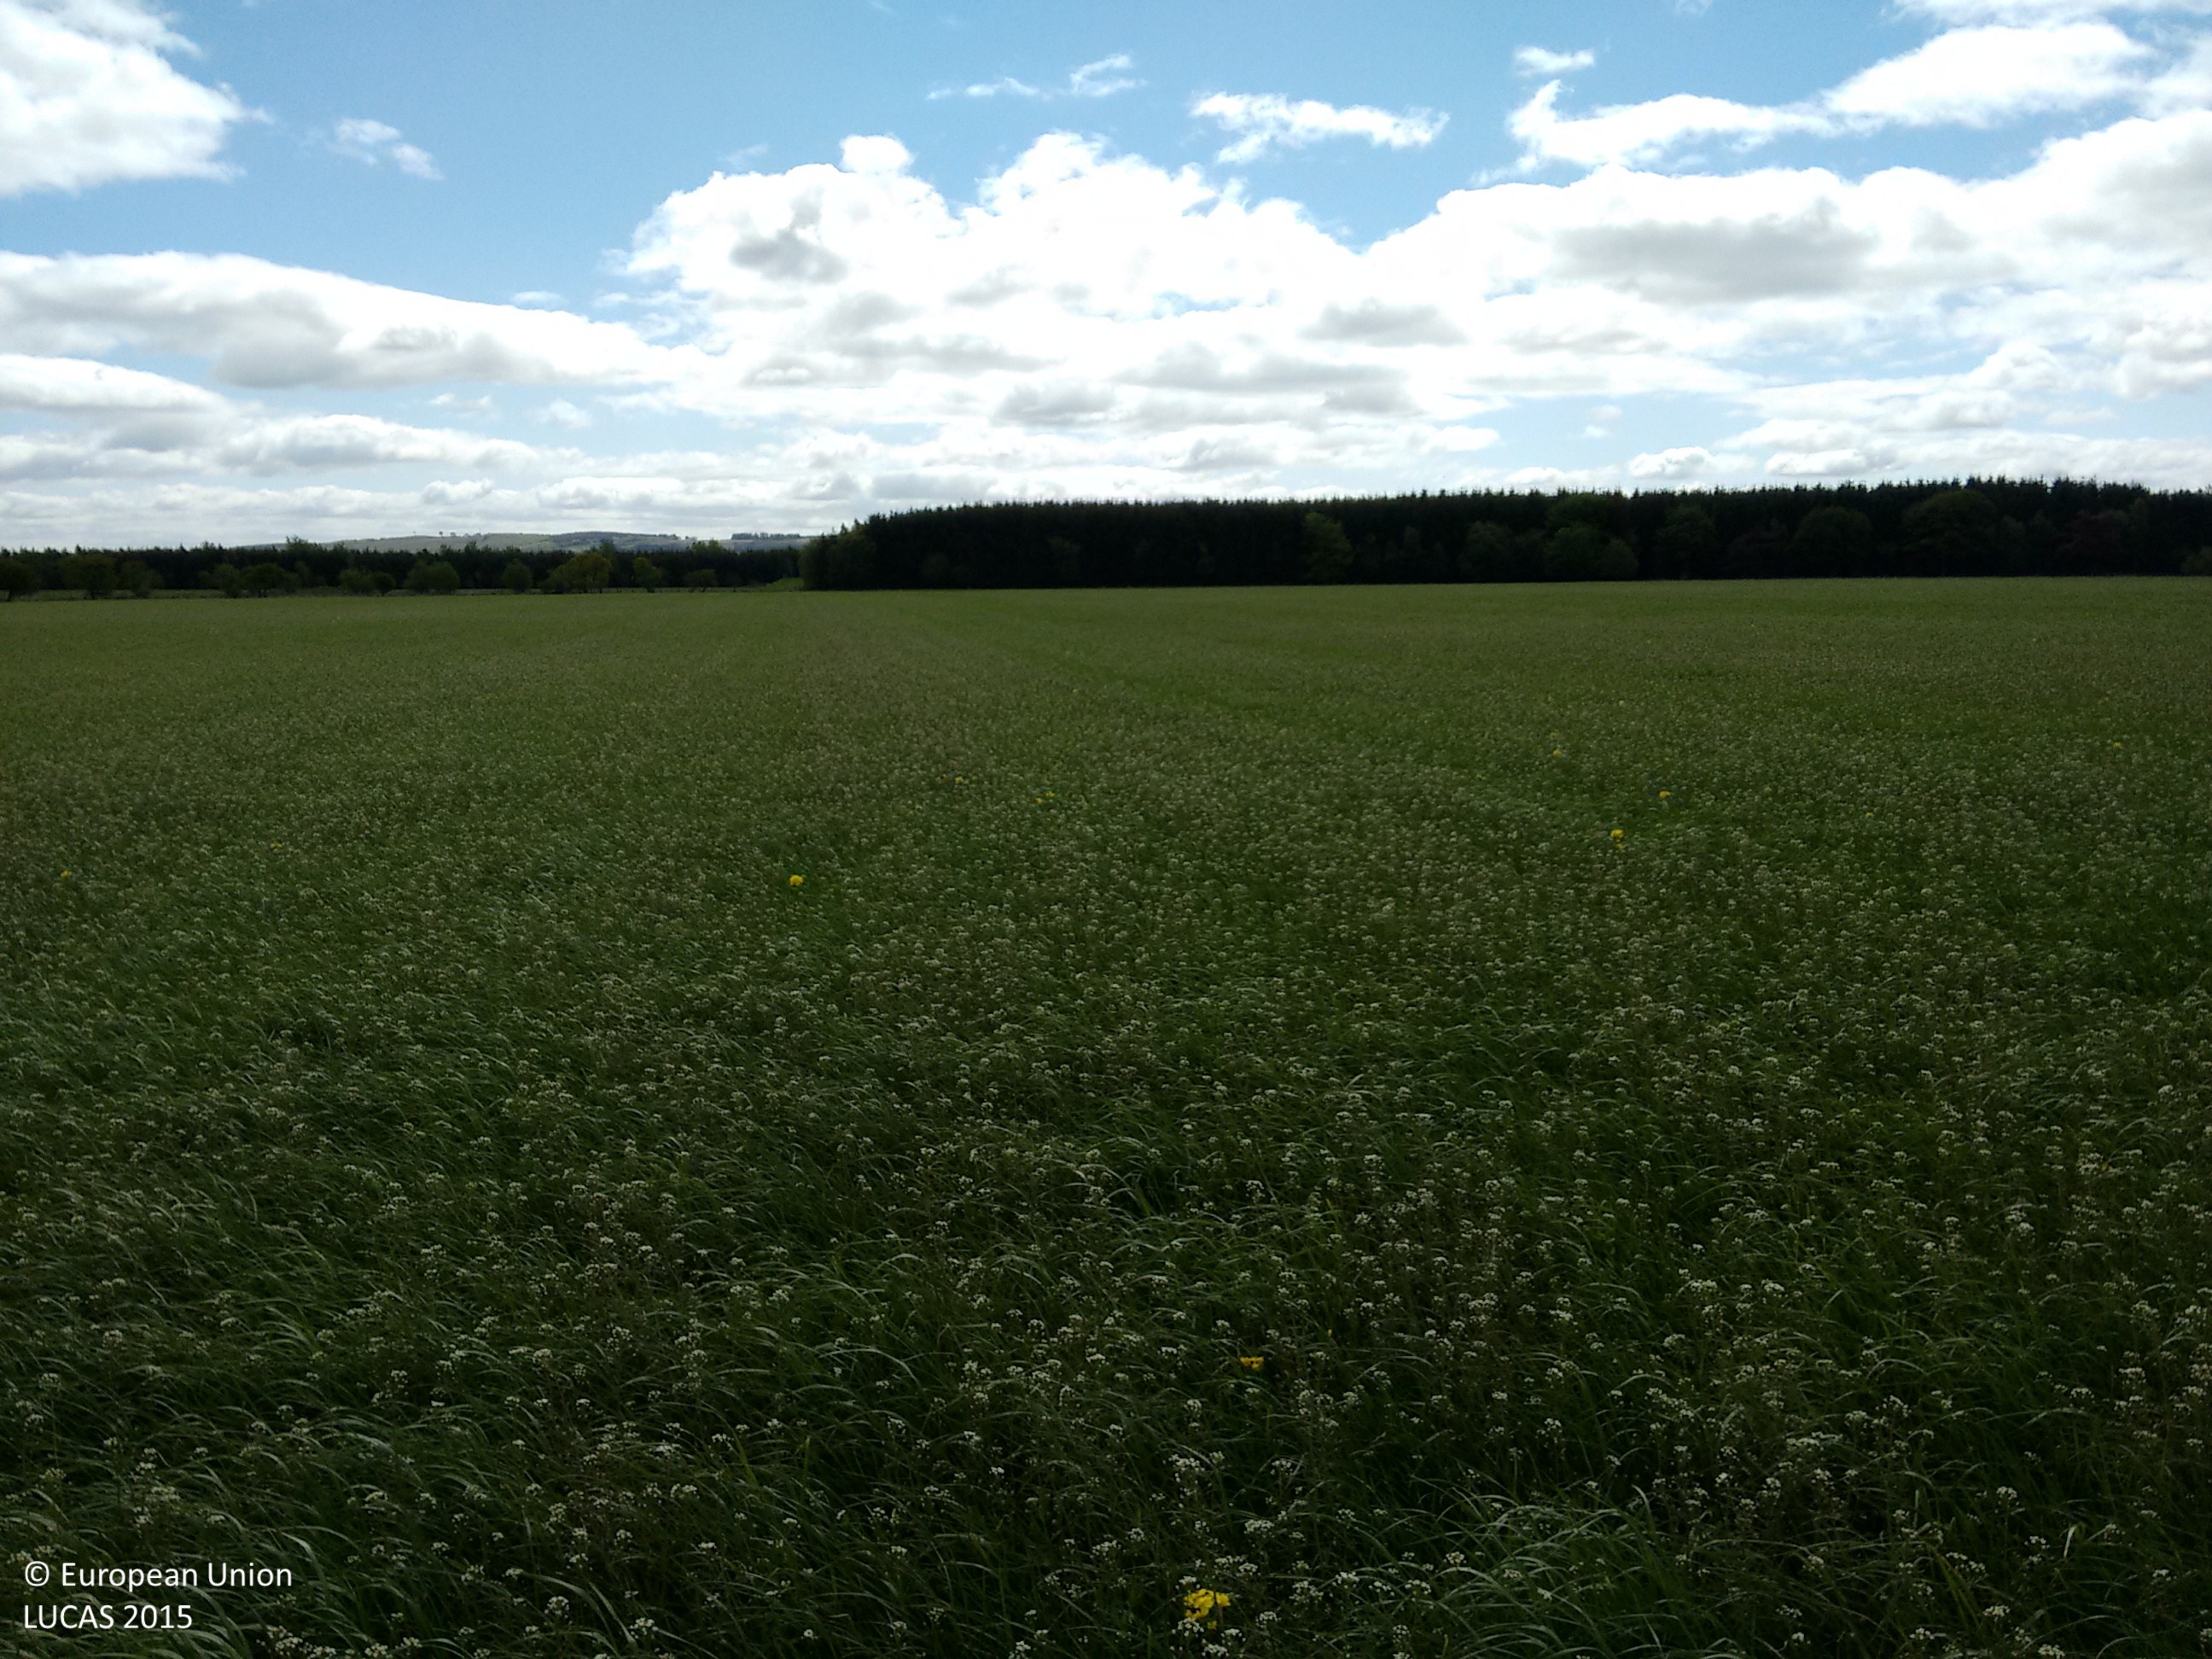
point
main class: Cropland
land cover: Mixed cereals for fodder
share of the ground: > 75 %
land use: Agriculture (excluding fallow land and kitchen gardens)
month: May
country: GB
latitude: 56.2034
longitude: -3.4712
